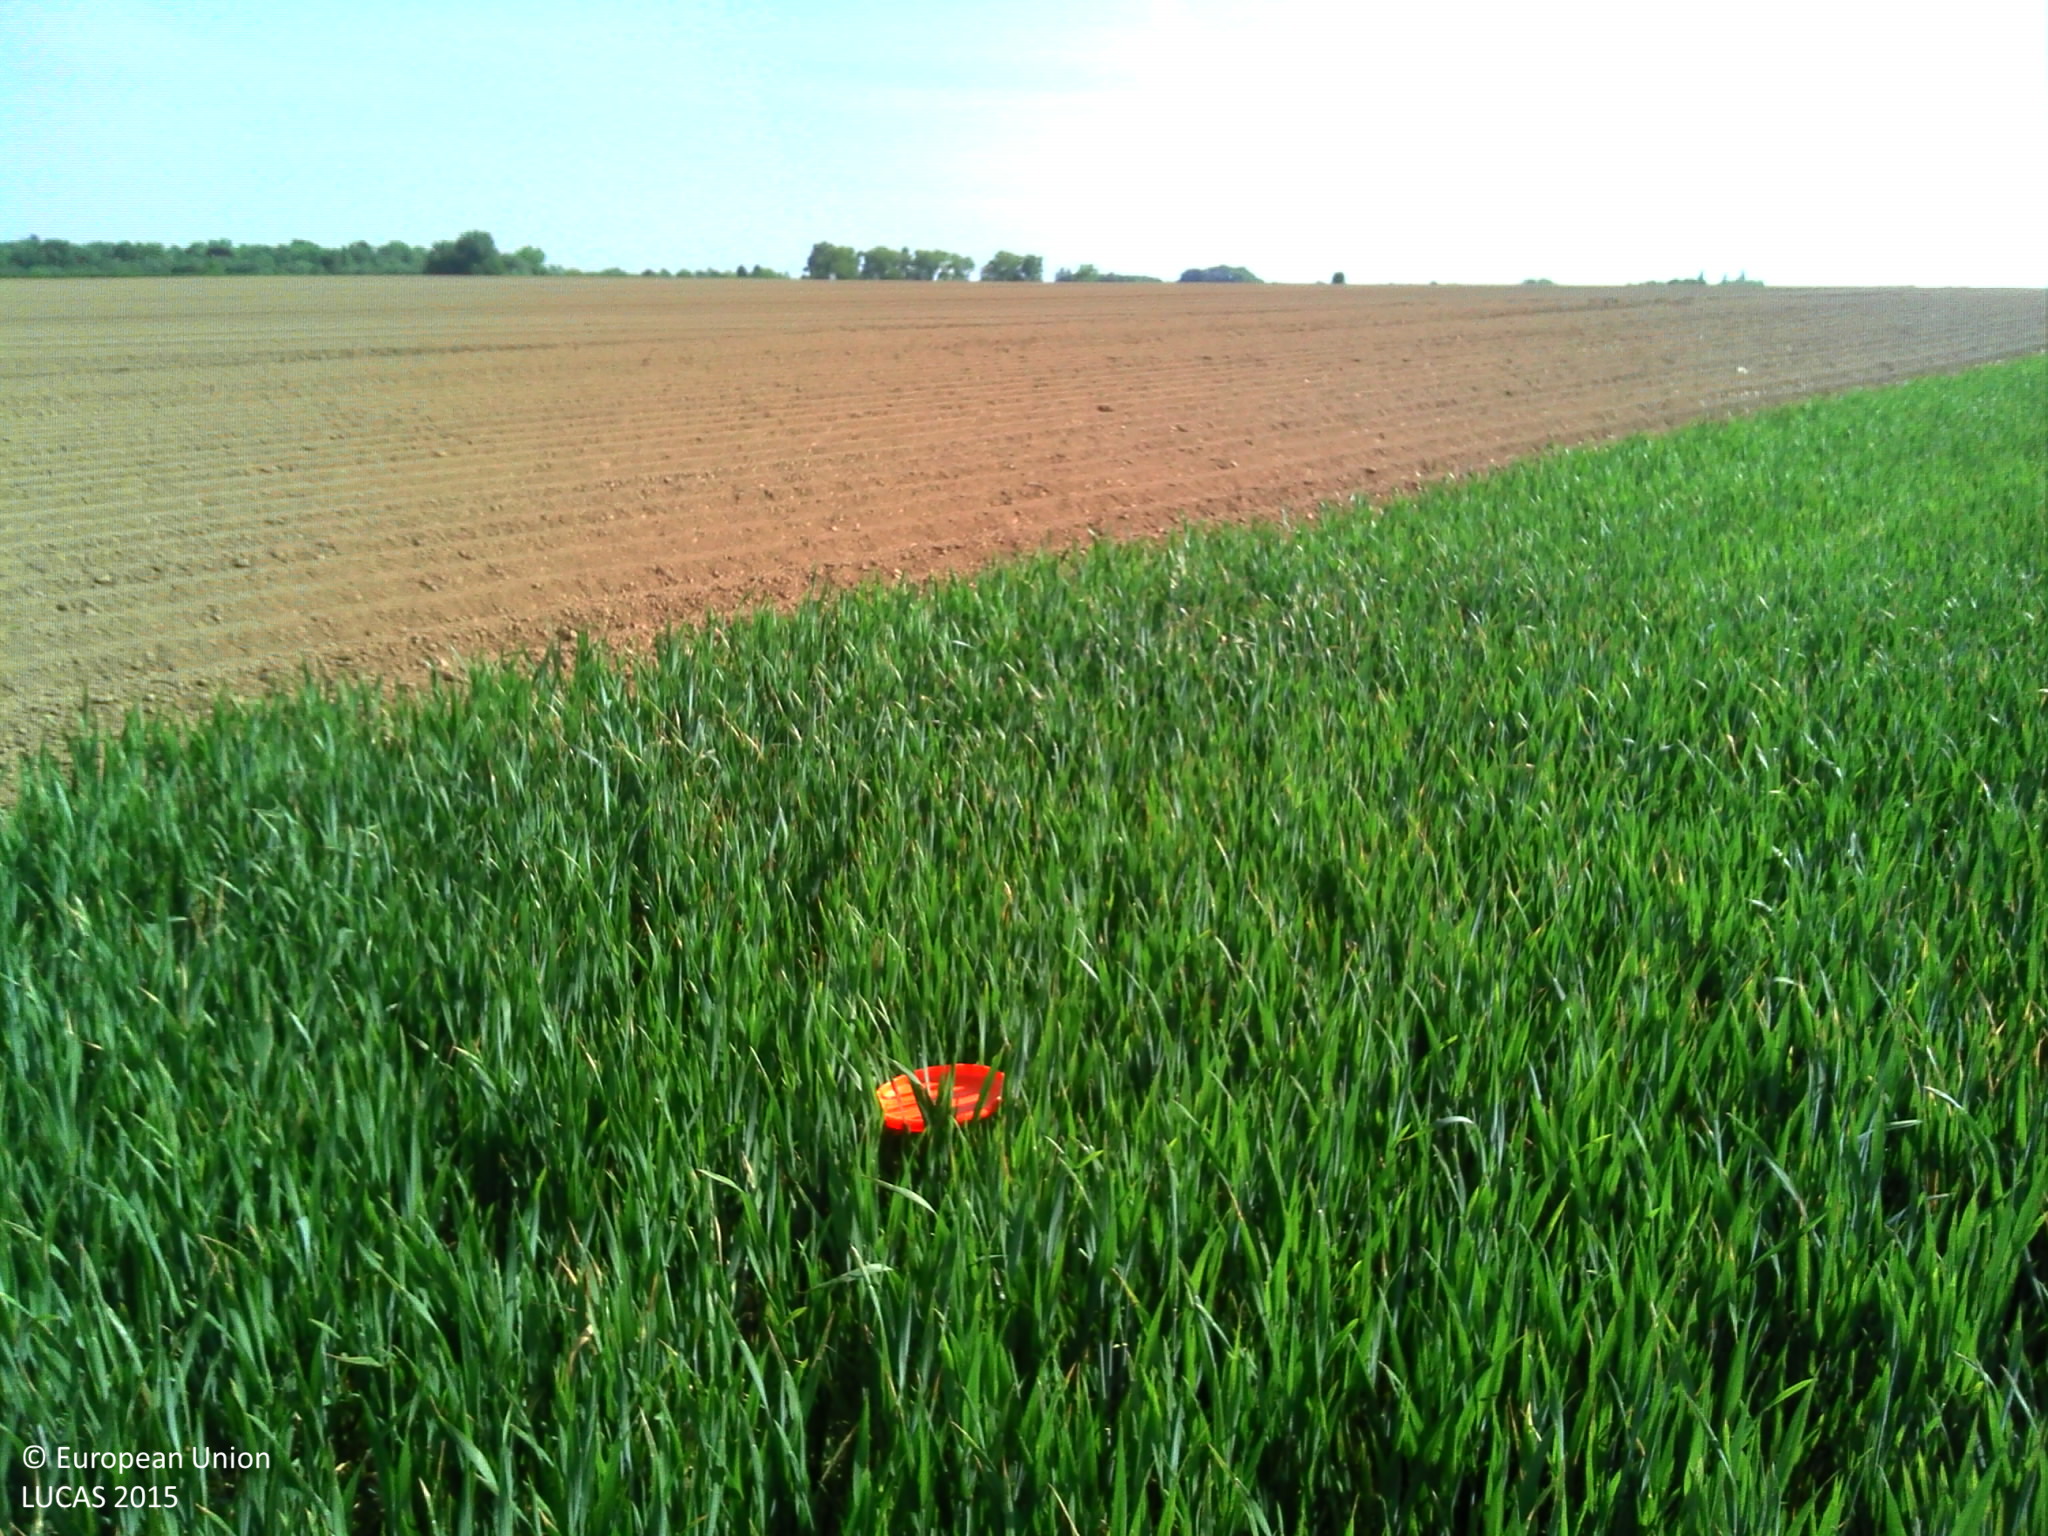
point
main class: Cropland
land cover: Common wheat
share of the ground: > 75 %
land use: Agriculture (excluding fallow land and kitchen gardens)
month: May
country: BE
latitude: 50.5631
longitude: 4.6458
